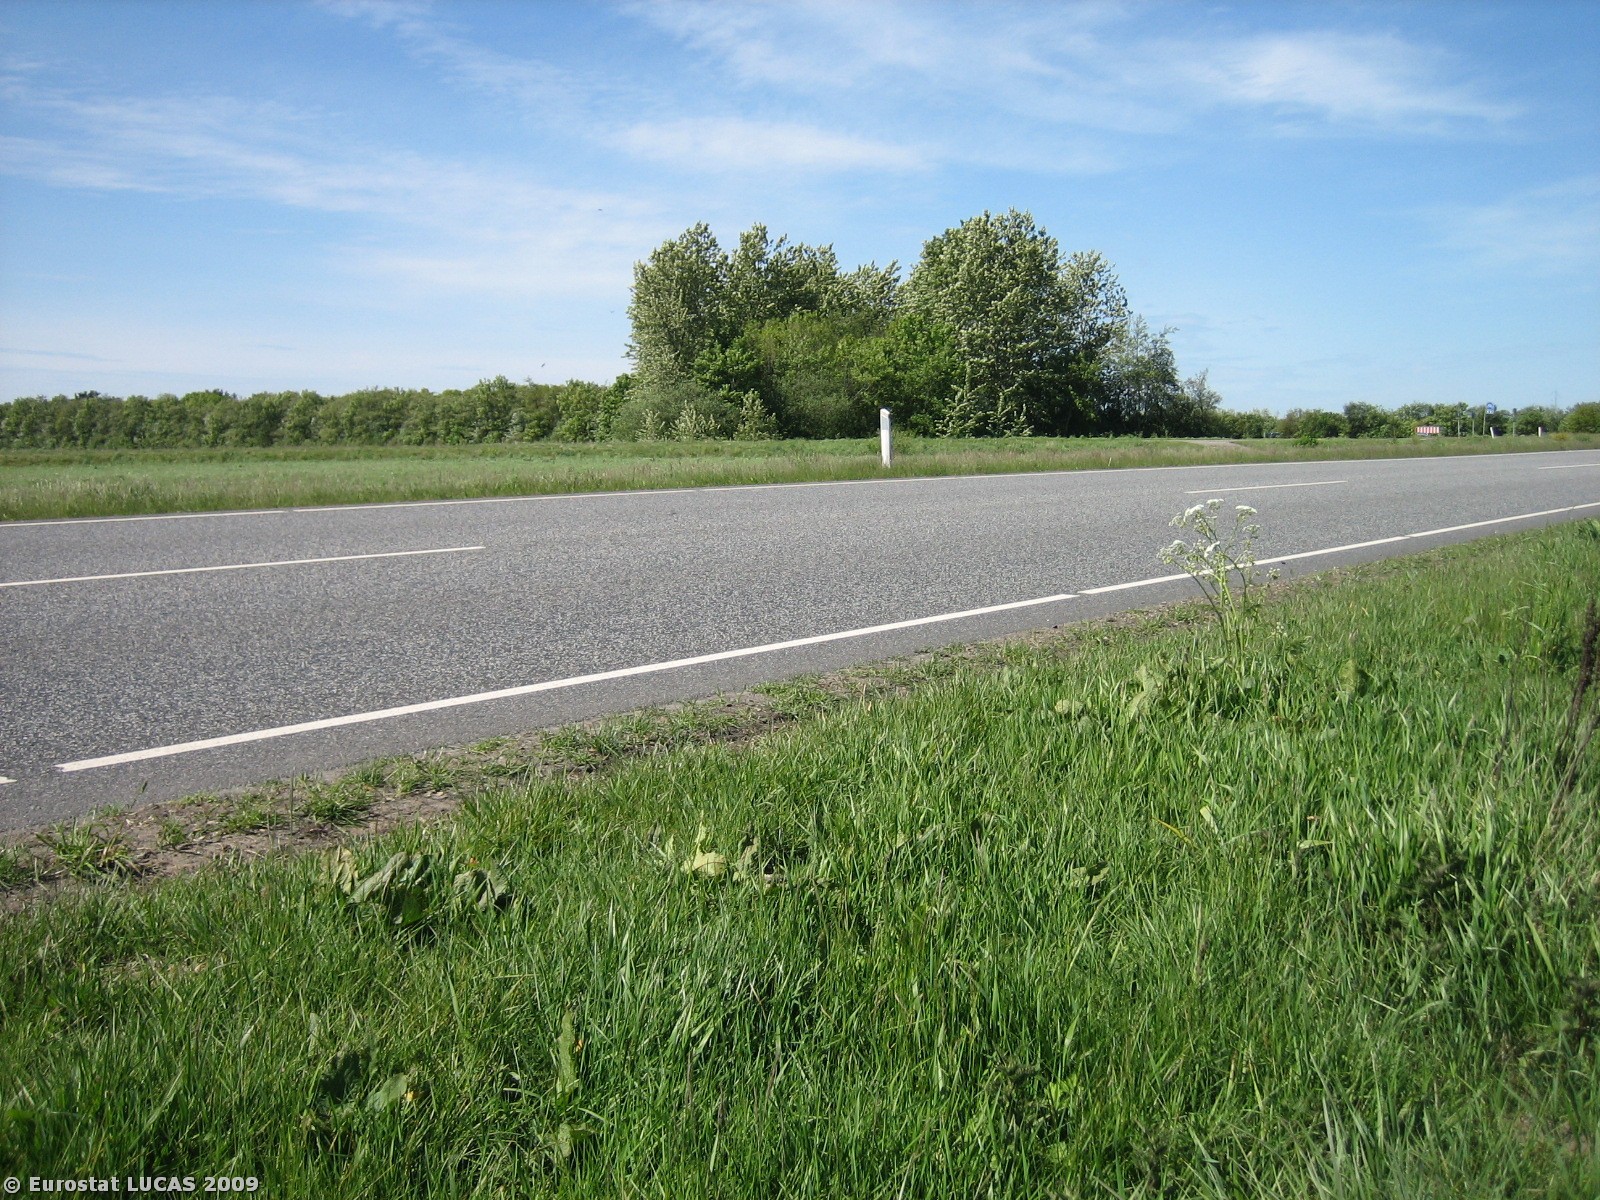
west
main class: Grassland
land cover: Grassland without tree/shrub cover
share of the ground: > 75 %
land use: Unused
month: May
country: DK
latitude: 55.9630
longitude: 8.4797
